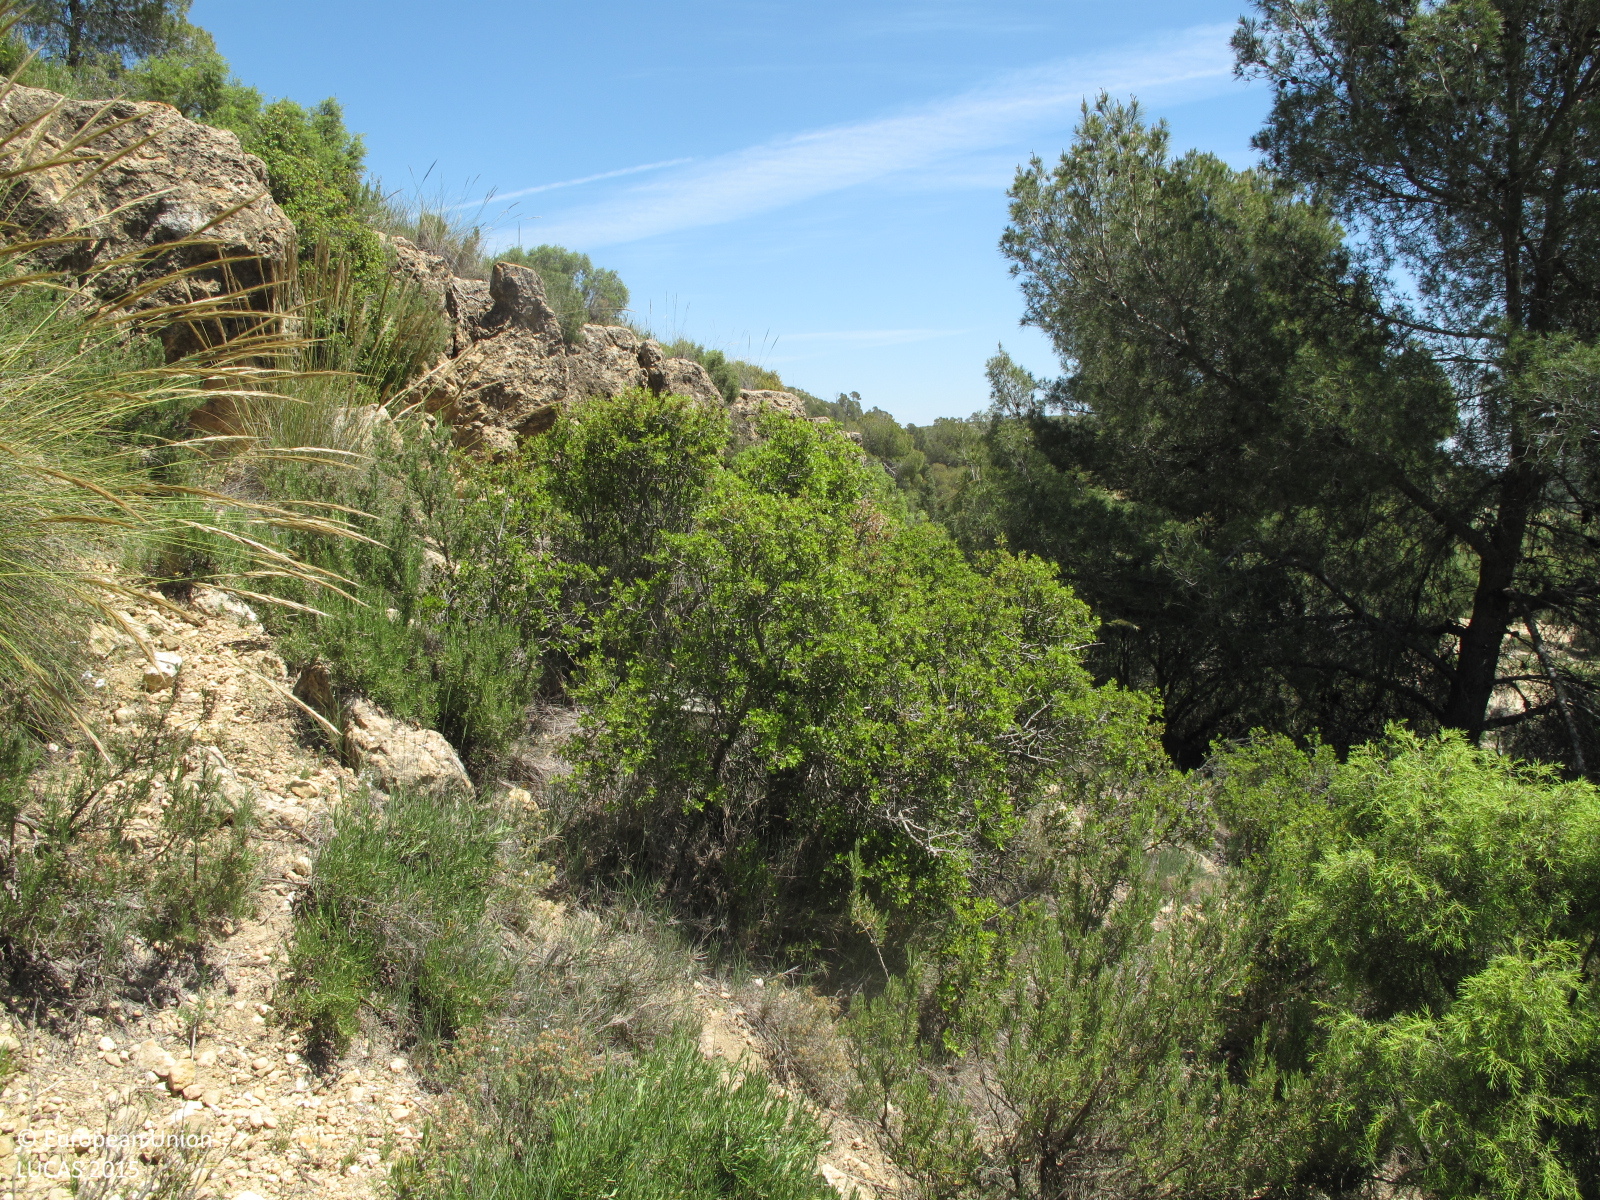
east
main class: Woodland
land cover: Pine dominated coniferous woodland
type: coniferous forest of the mediterranean region
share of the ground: 25 - 50 %
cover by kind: coniferous forest trees 40 %, shrubs 20 %, herbaceous plants 20 %, consolidated bare surface 20 %
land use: Semi-natural and natural areas not in use
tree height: > 5 m
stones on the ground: 25 - 50 %
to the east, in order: Pine dominated coniferous woodland; Rock outcrops; Pine dominated coniferous woodland; Shrubland with sparse tree cover; Shrubland without tree cover
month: May
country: ES
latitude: 38.8646
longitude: -0.9766
